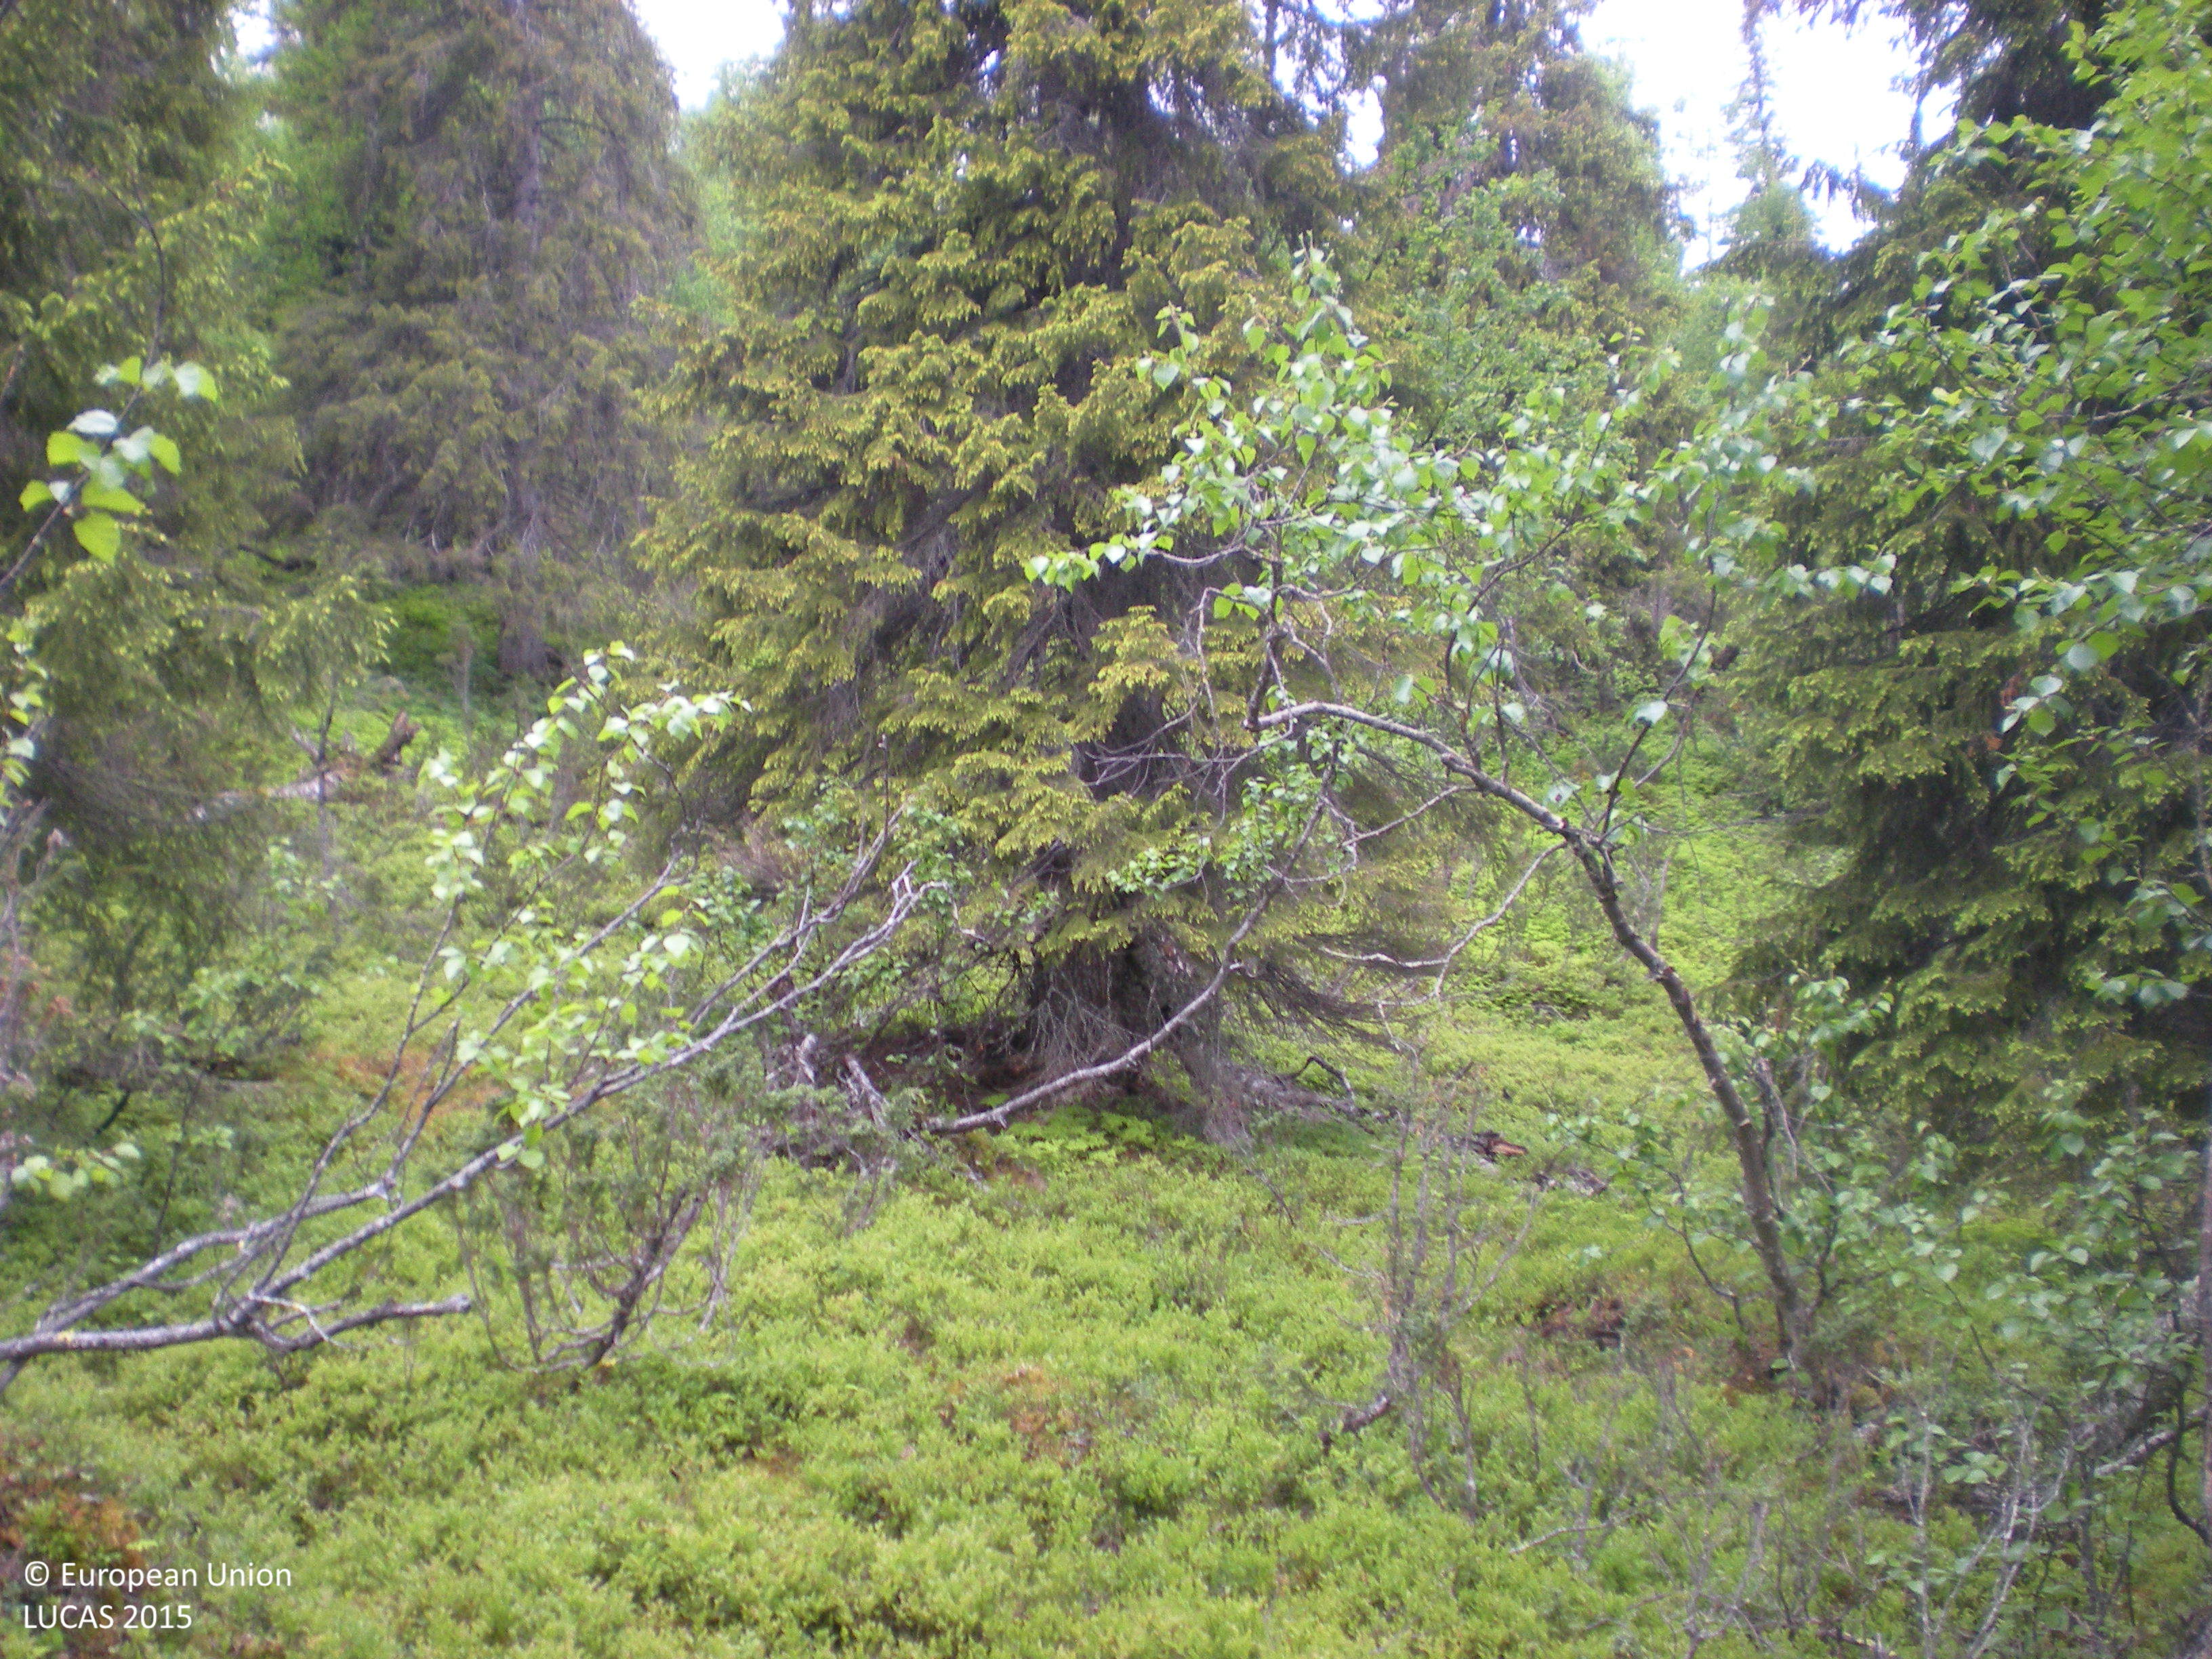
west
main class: Woodland
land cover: Spruce dominated mixed woodland
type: boreal forest
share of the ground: 50 - 75 %
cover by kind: coniferous forest trees 55 %, broadleaved forest trees 20 %, shrubs 20 %, lichens and mosses 5 %
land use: Semi-natural and natural areas not in use
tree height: > 5 m
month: July
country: SE
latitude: 66.1214
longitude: 17.2390
